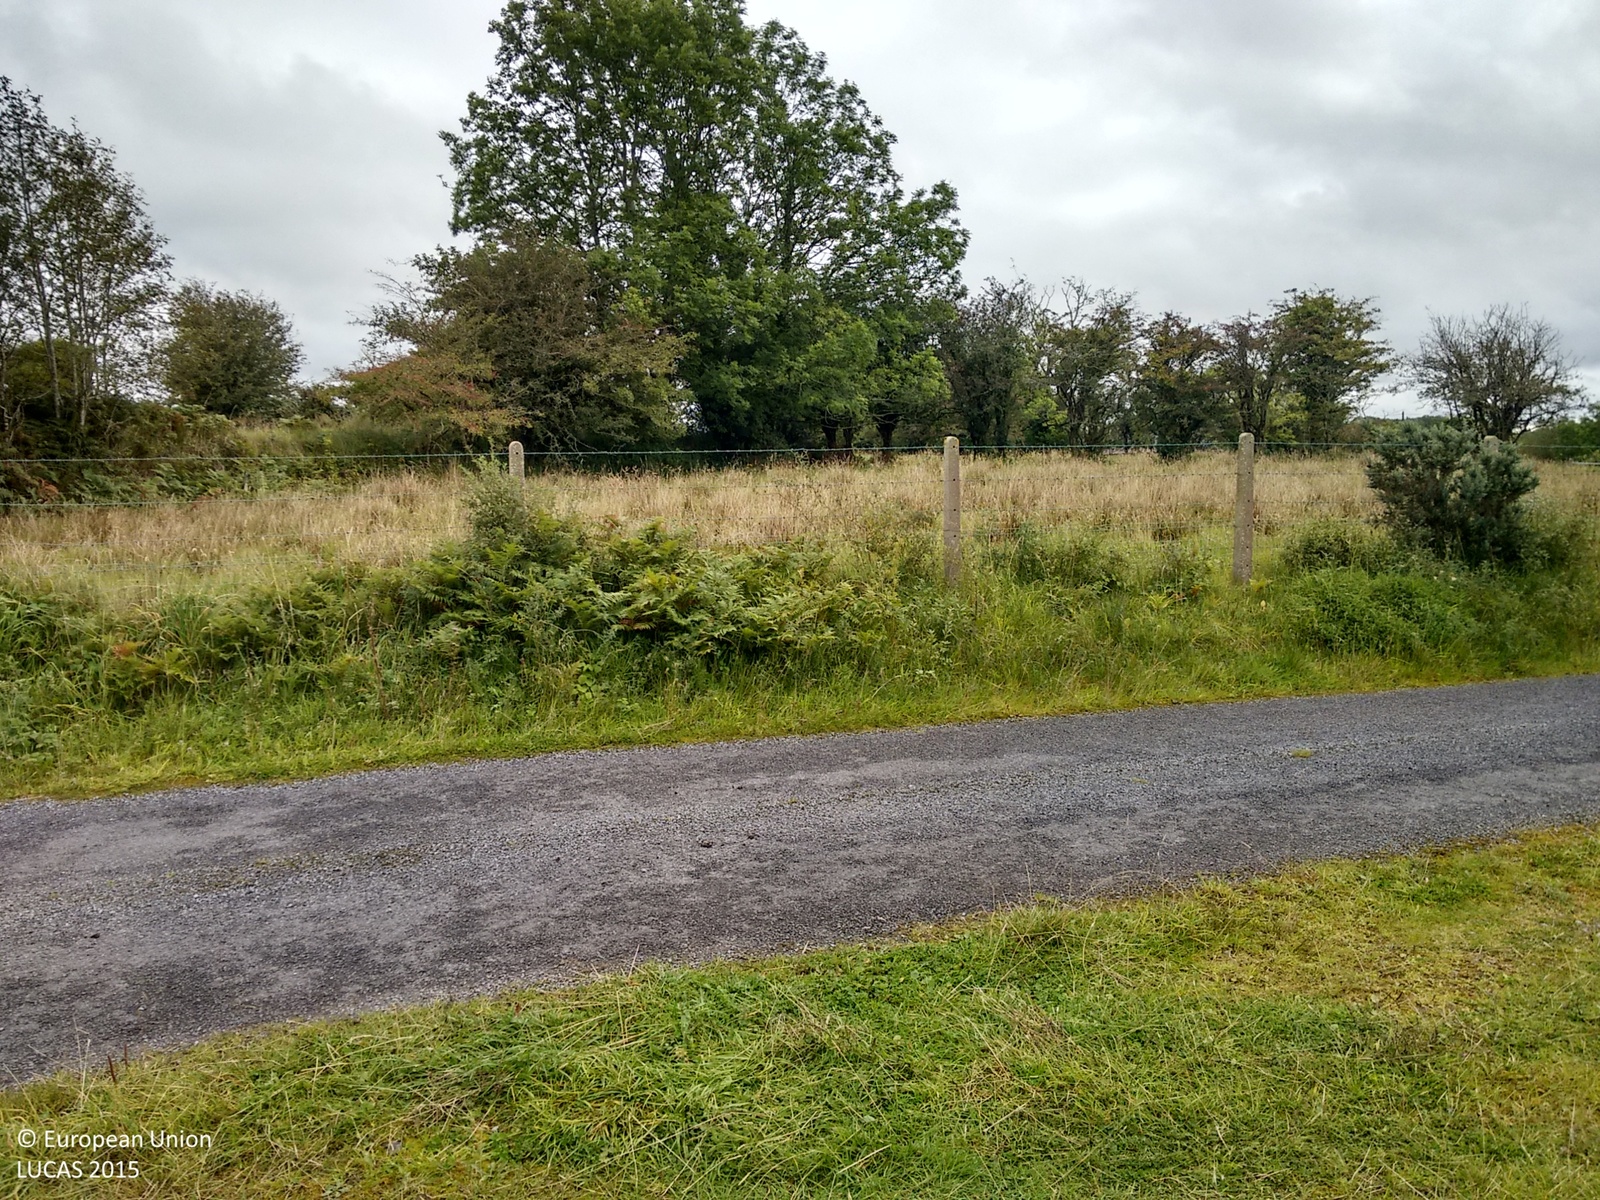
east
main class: Grassland
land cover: Grassland without tree/shrub cover
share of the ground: > 75 %
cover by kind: herbaceous plants 100 %
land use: Agriculture (excluding fallow land and kitchen gardens)
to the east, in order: Grassland without tree/shrub cover; Spruce dominated coniferous woodland; Grassland without tree/shrub cover; Fences; Rivers and streams; Grassland without tree/shrub cover; Abandoned hedges; Grassland without tree/shrub cover; Fences; Abandoned hedges
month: September
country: IE
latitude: 53.8120
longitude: -8.9353
